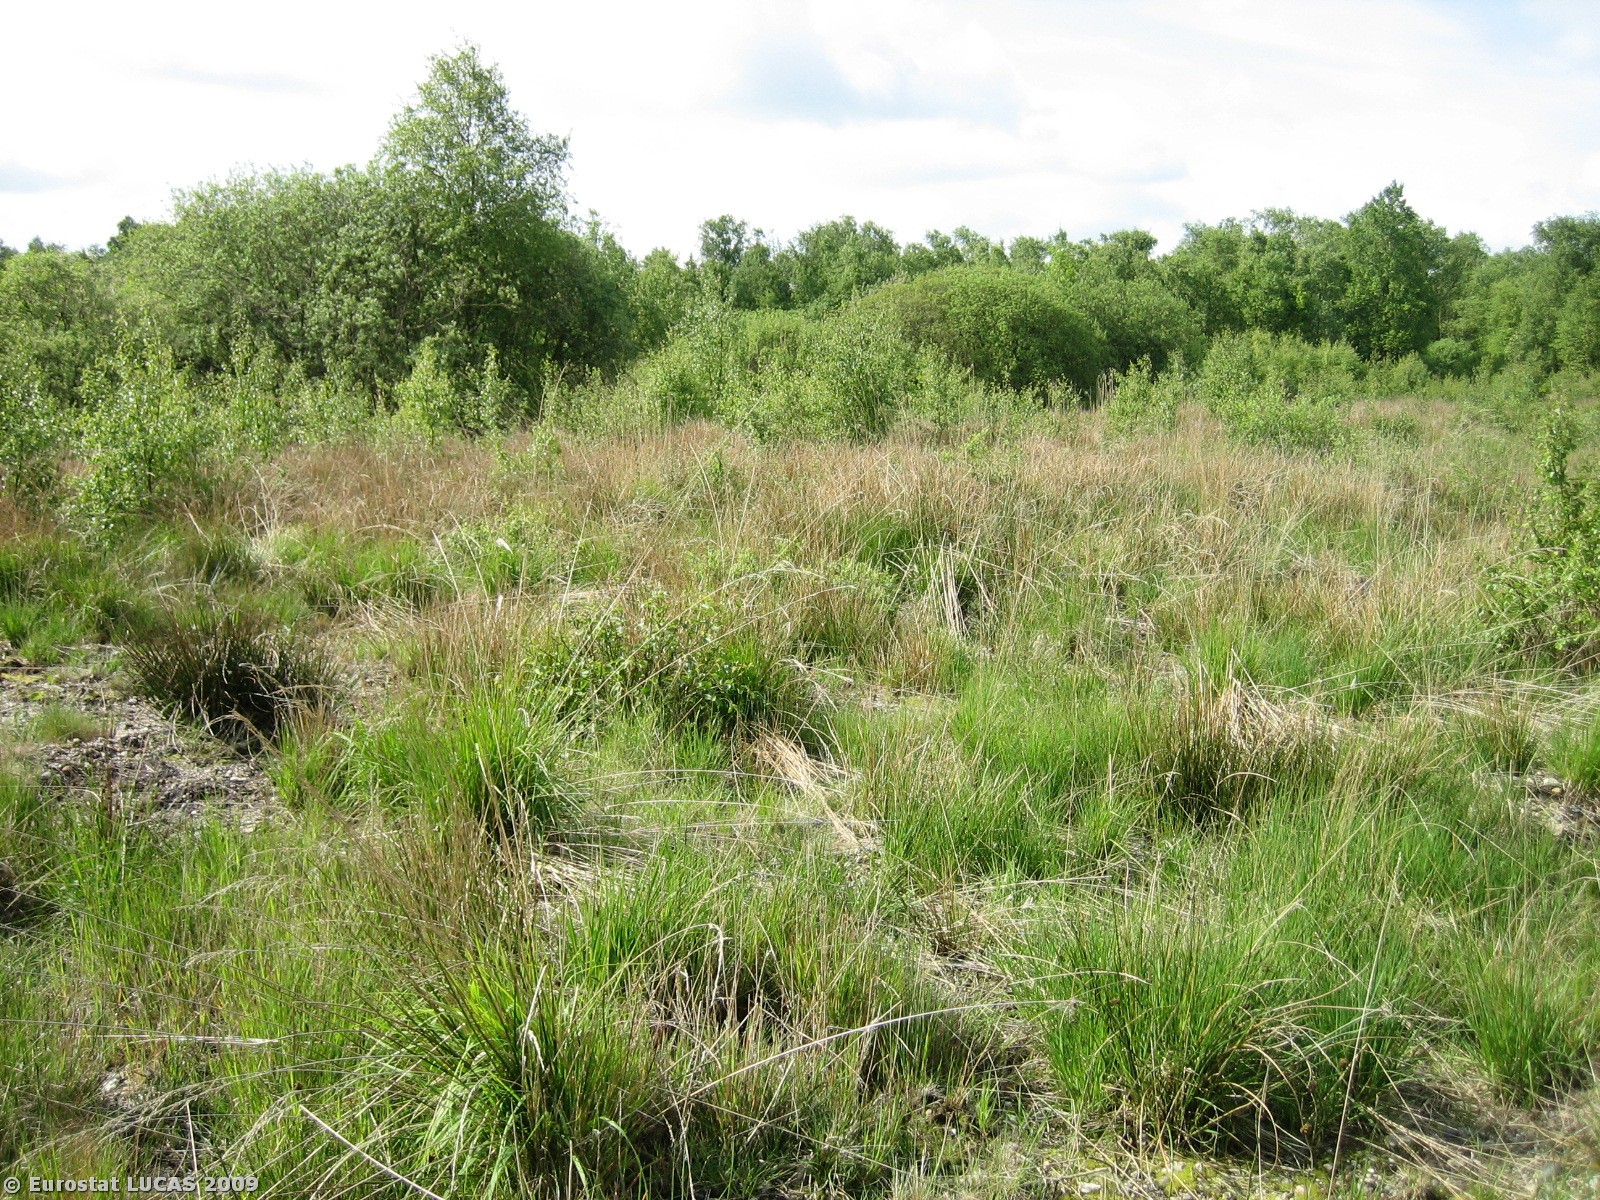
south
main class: Shrubland
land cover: Shrubland with sparse tree cover
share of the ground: > 75 %
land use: Unused
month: May
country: DK
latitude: 56.0928
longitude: 8.8601
